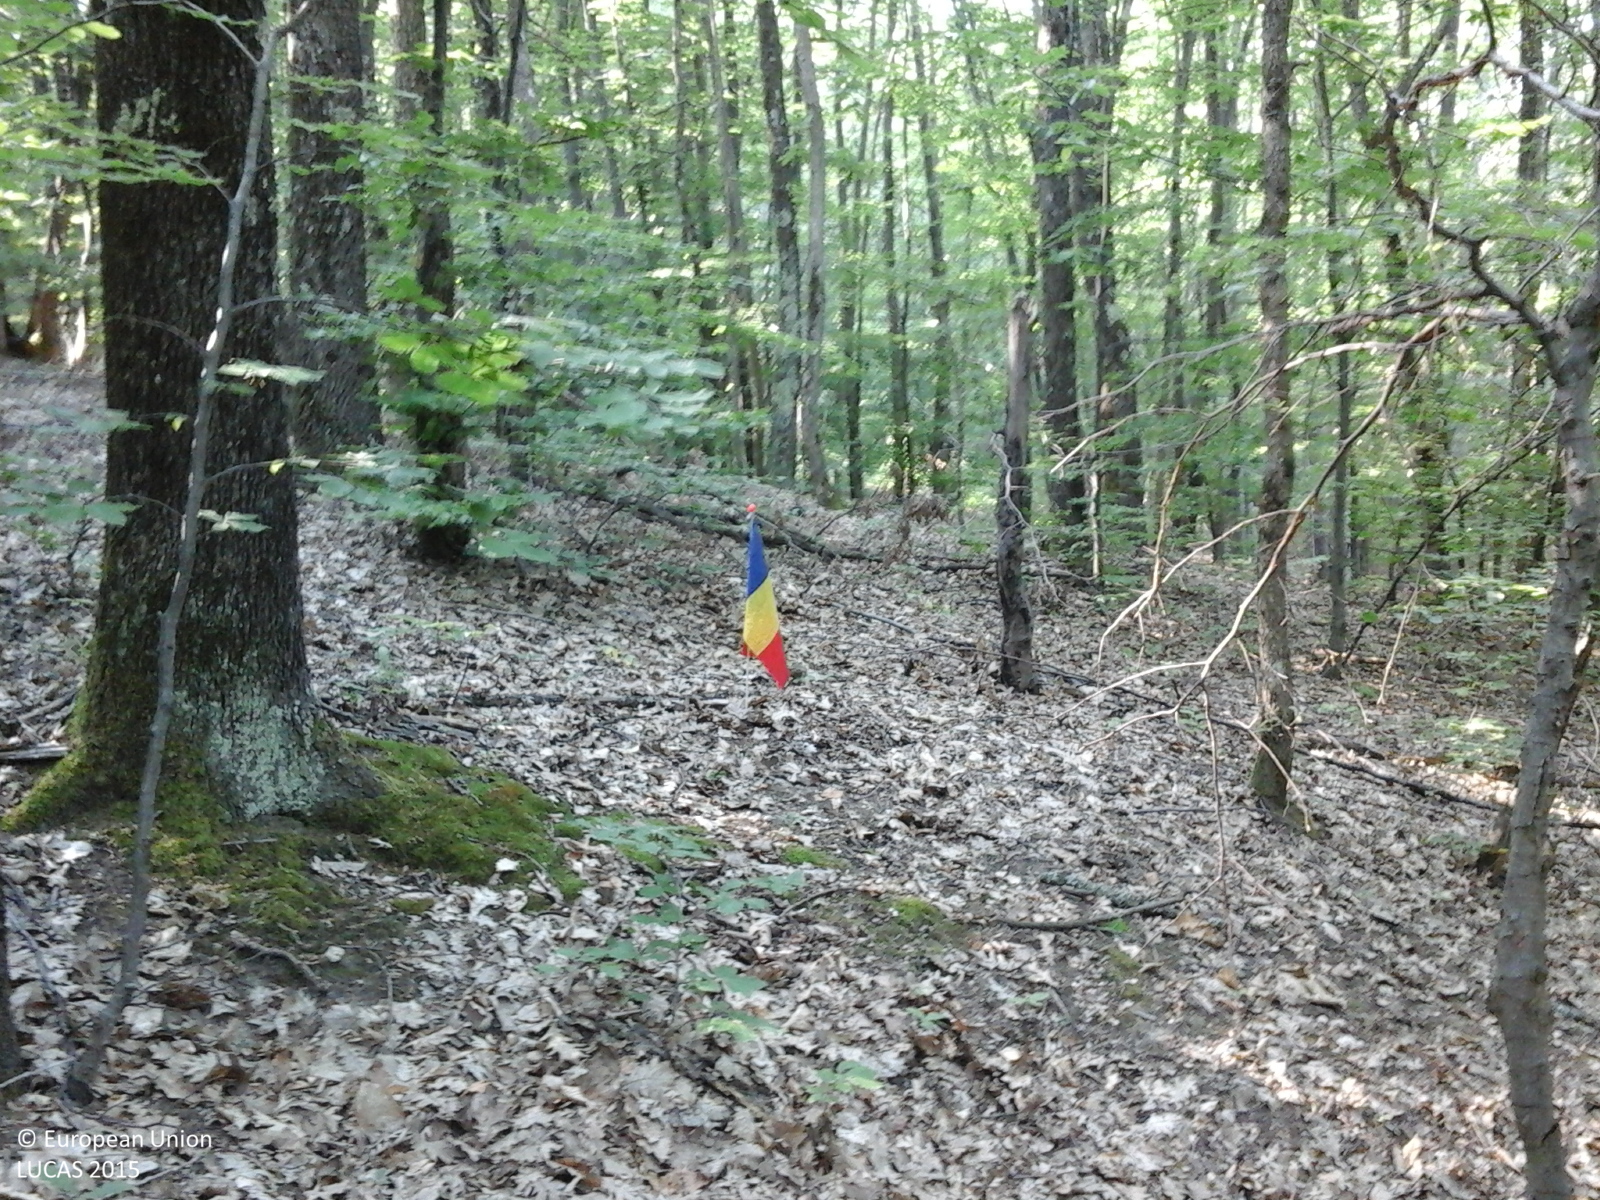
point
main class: Woodland
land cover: Broadleaved woodland
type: acidophilous oak and oak-birch forest
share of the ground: > 75 %
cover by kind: broadleaved forest trees 100 %
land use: Forestry
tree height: > 5 m
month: July
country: RO
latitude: 44.9668
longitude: 24.6715
